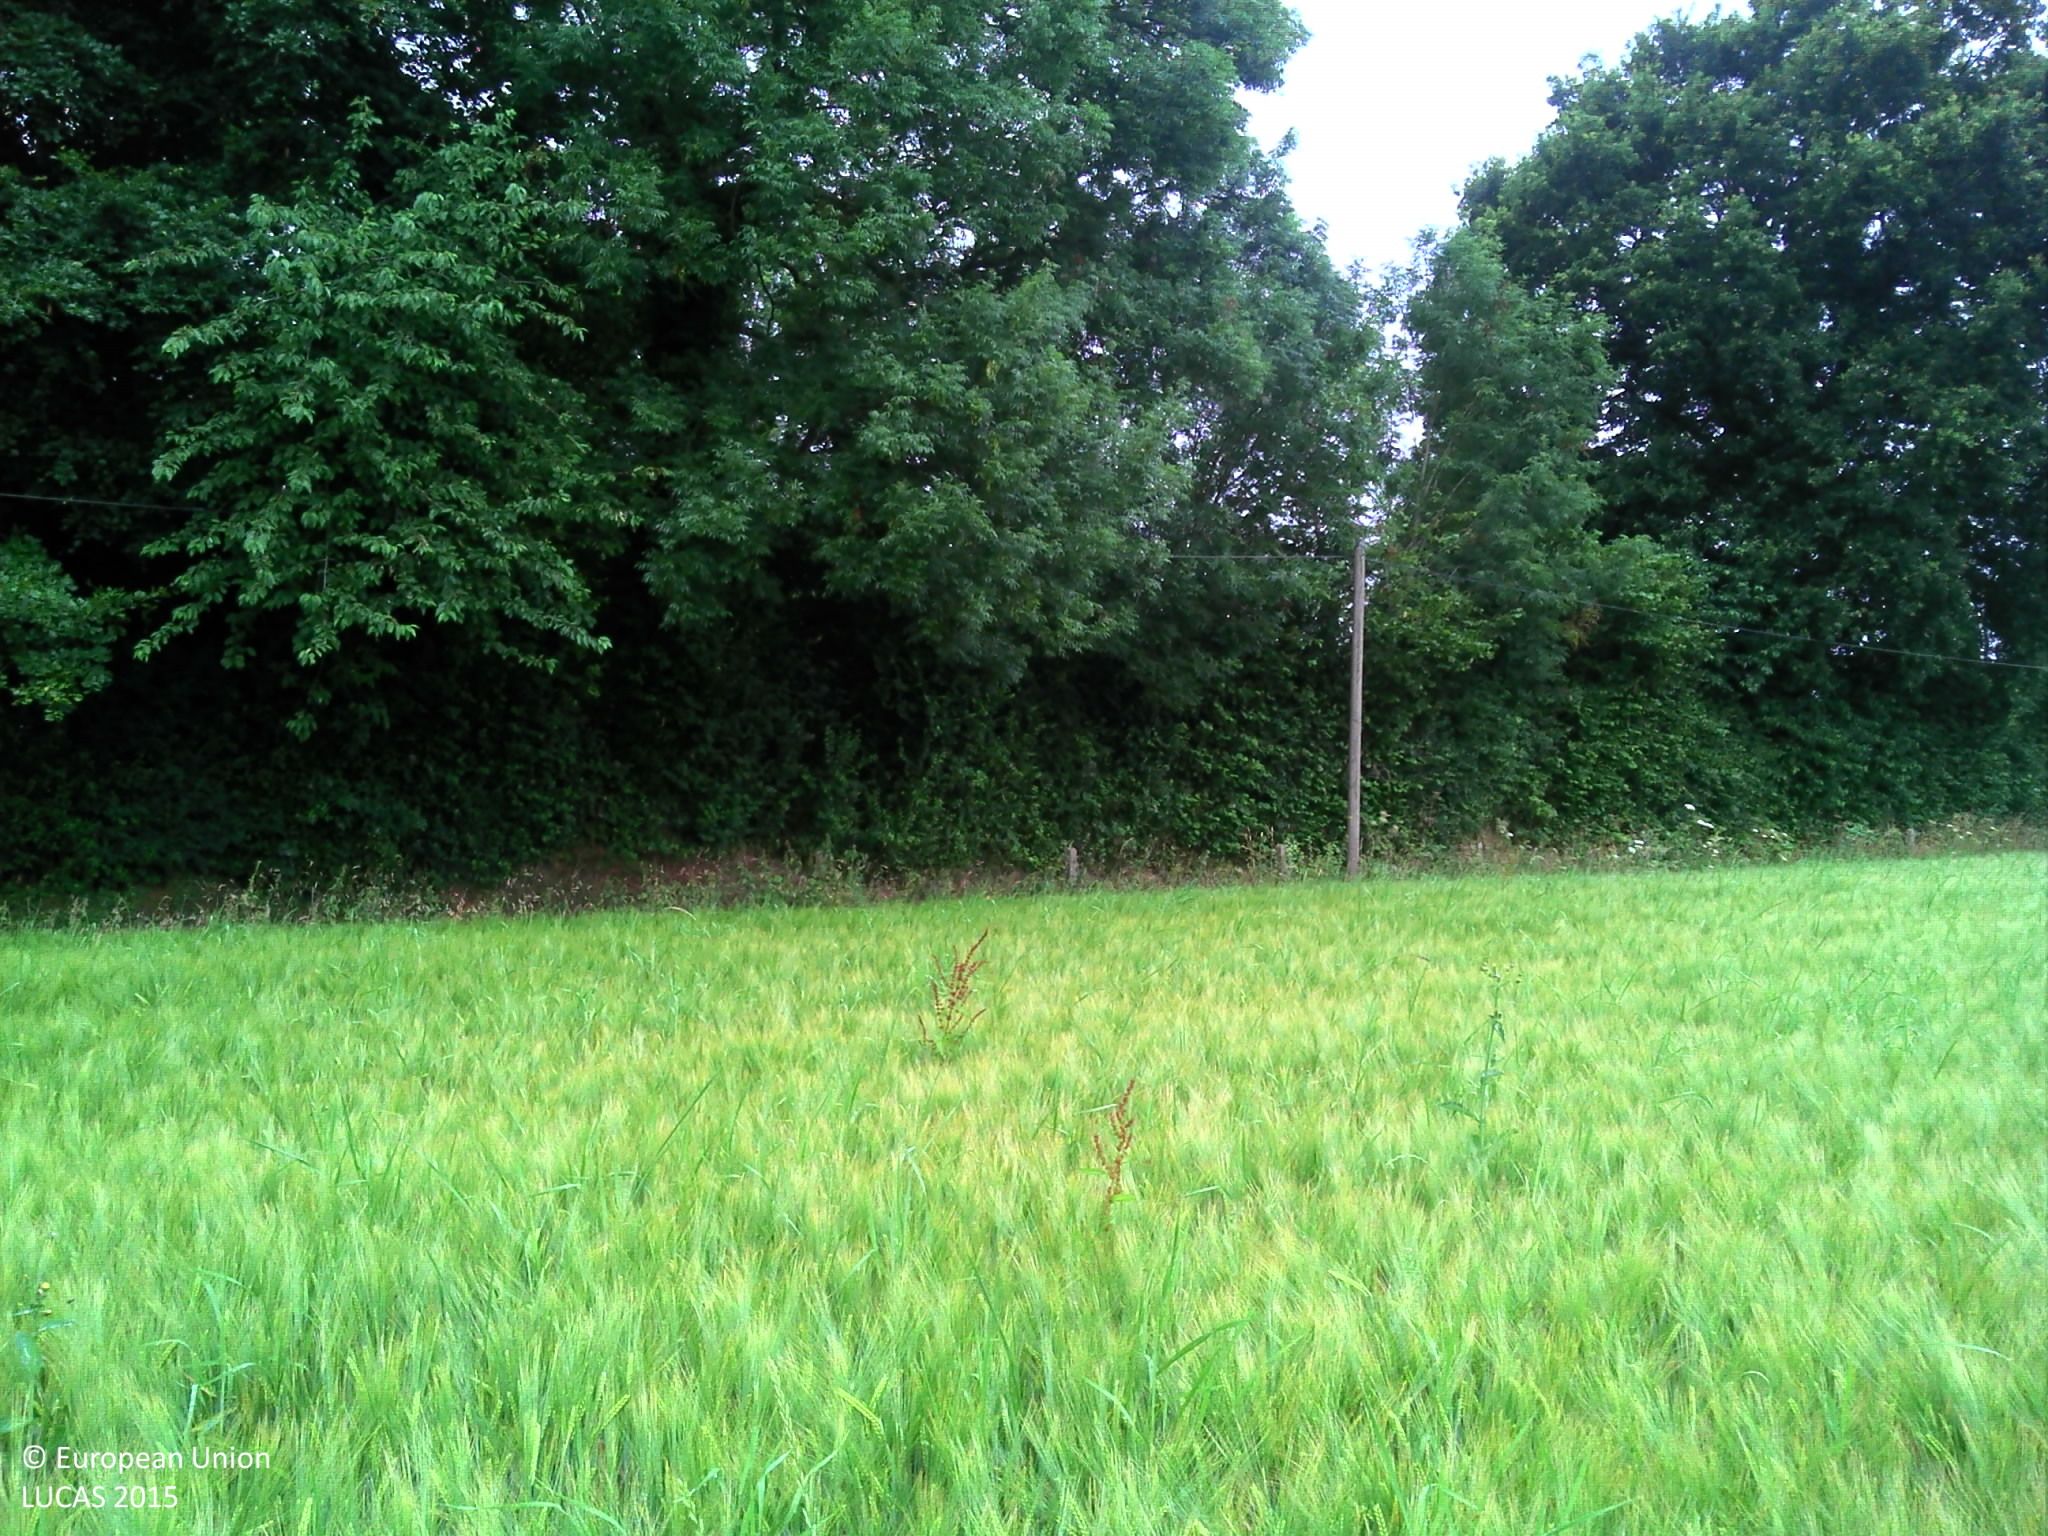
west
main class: Cropland
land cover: Triticale
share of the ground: > 75 %
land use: Agriculture (excluding fallow land and kitchen gardens)
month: July
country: FR
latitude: 49.3038
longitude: 0.3590
